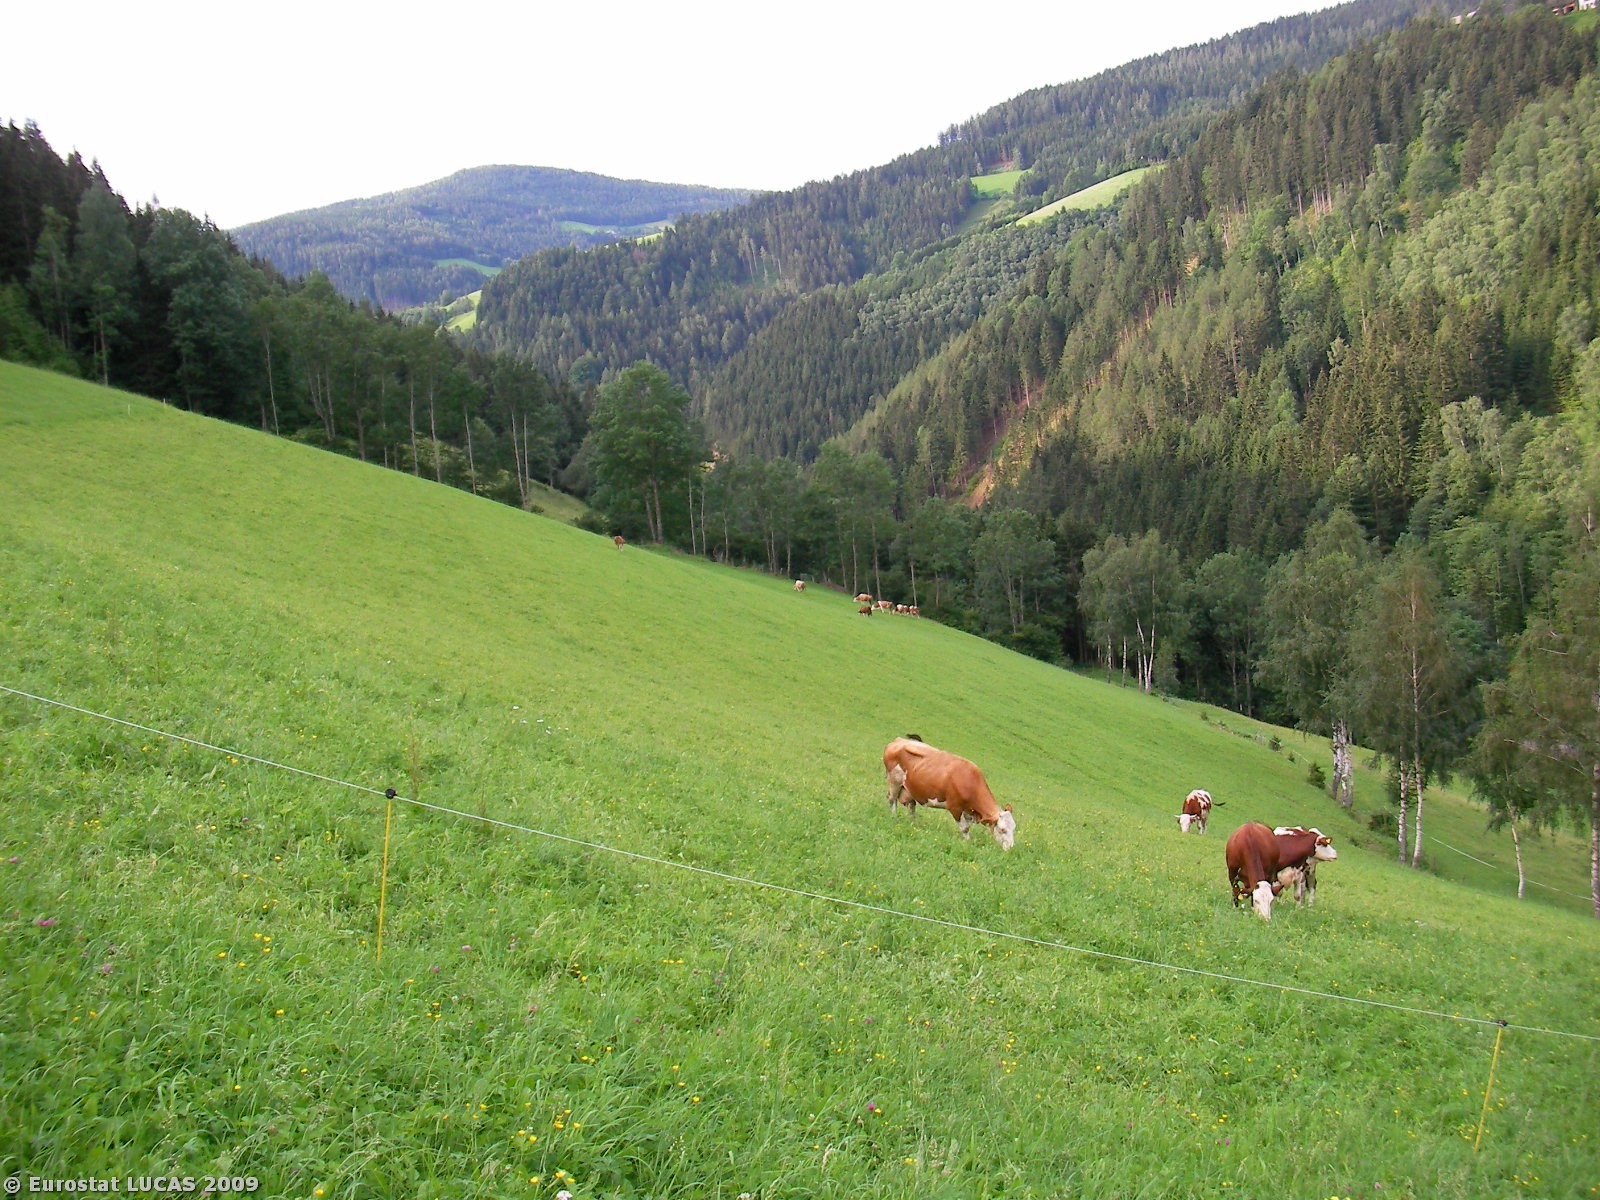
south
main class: Grassland
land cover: Grassland without tree/shrub cover
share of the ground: > 75 %
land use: Agriculture (excluding fallow land and kitchen gardens)
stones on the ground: < 10 %
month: July
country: AT
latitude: 47.3761
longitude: 15.6297
